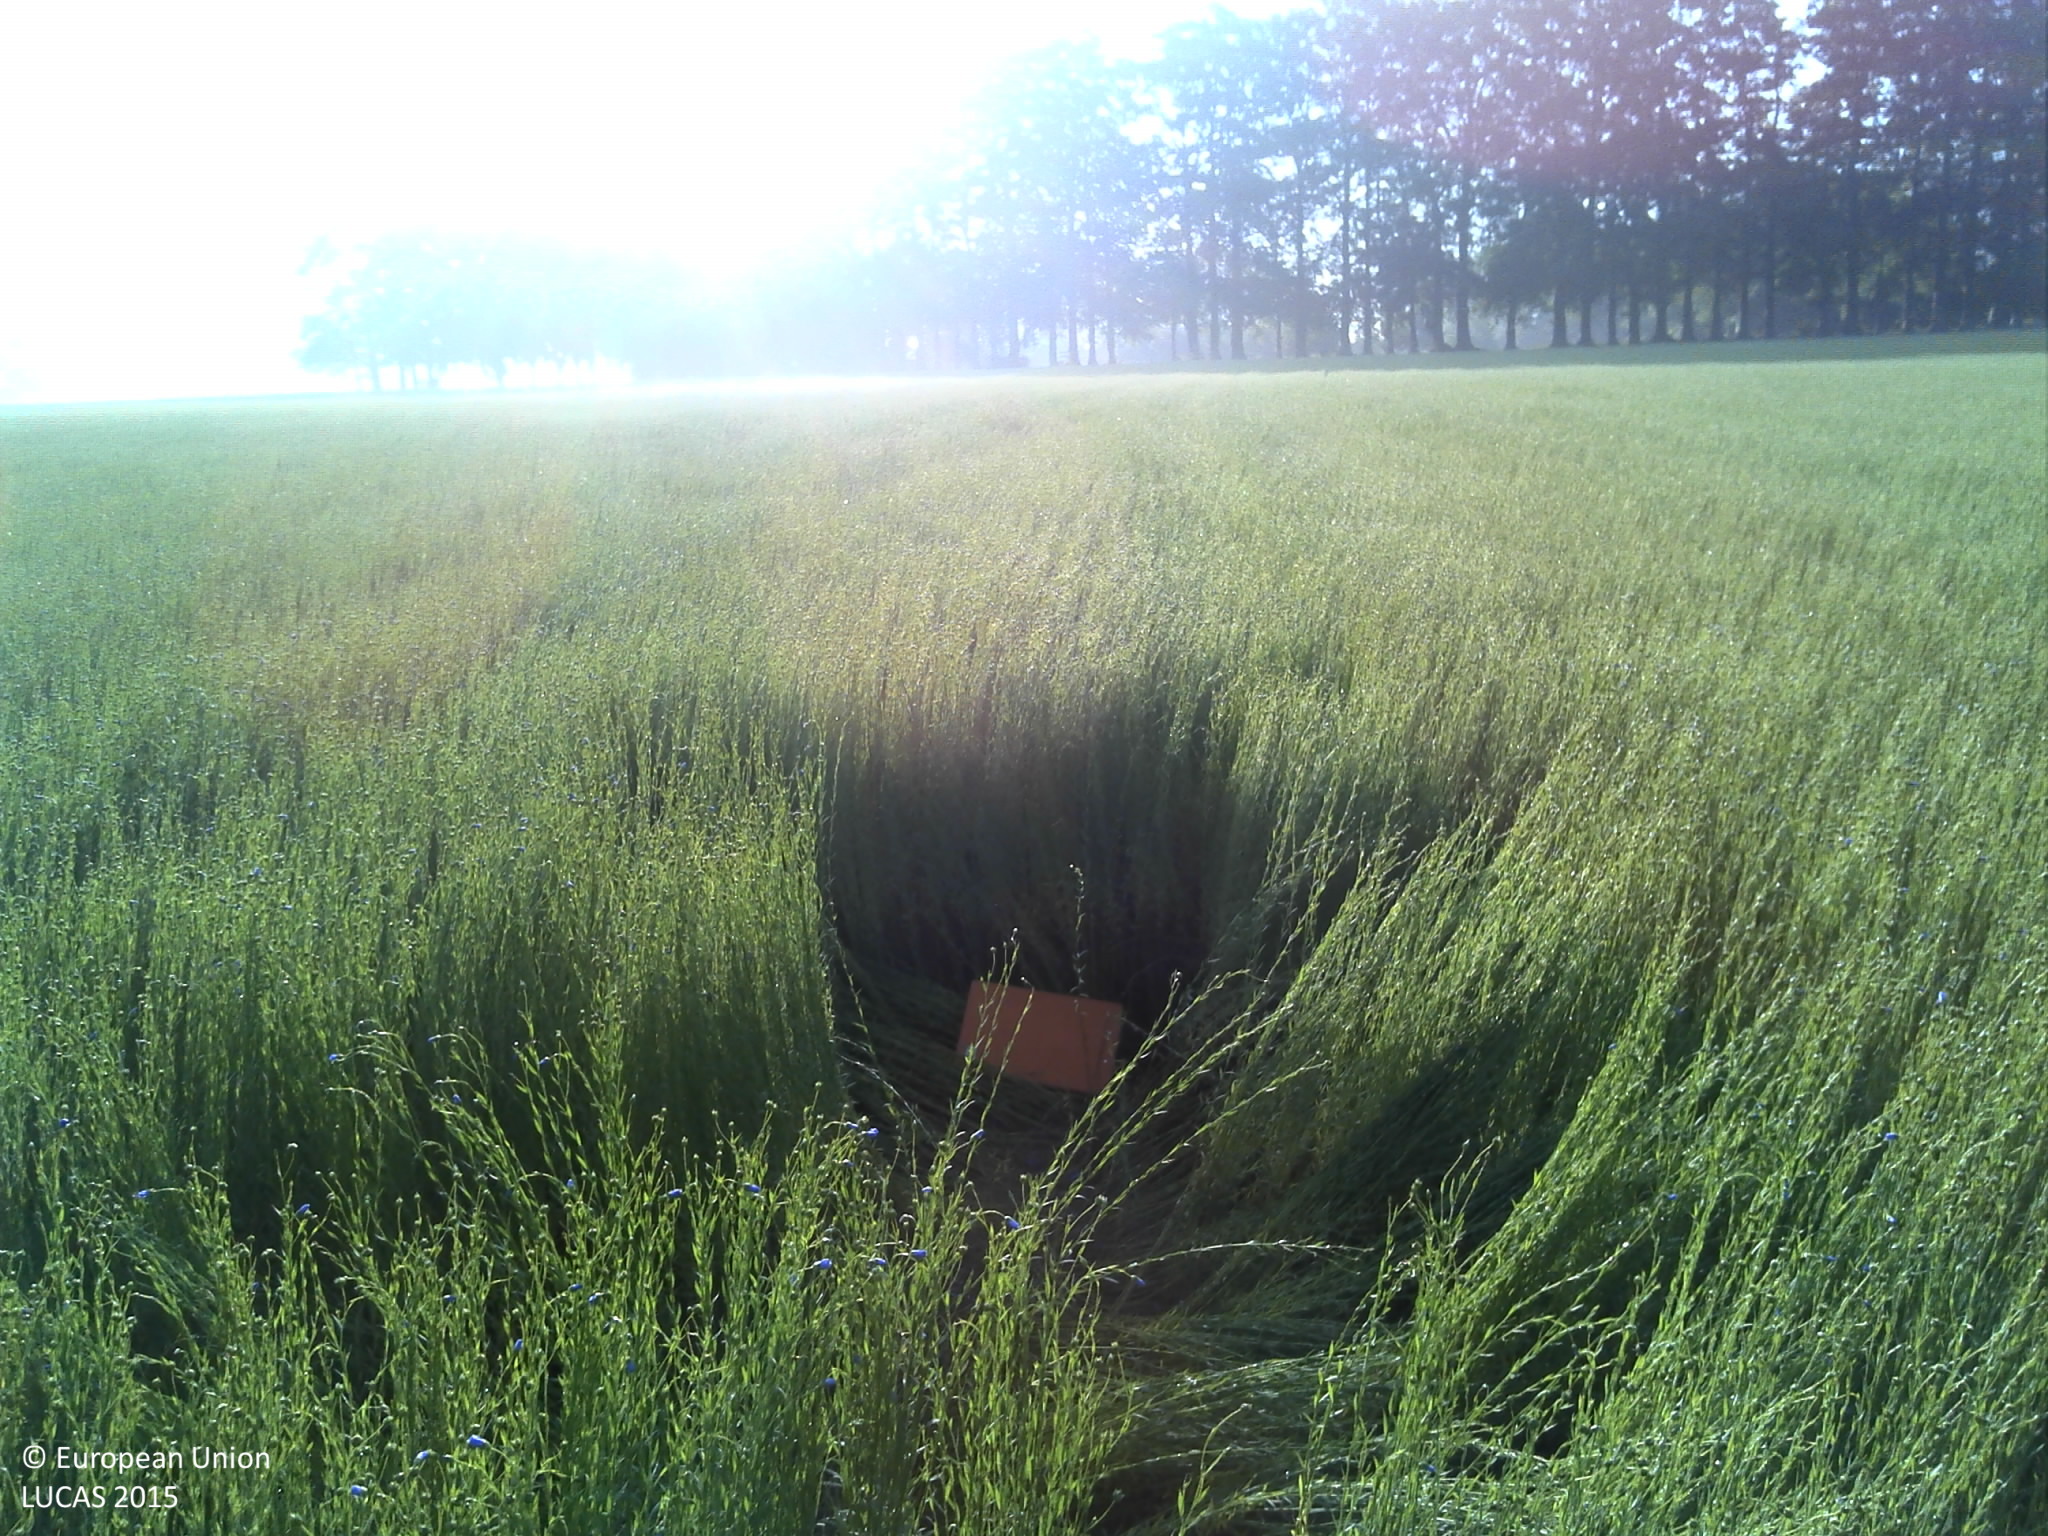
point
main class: Cropland
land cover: Other fibre and oleaginous crops
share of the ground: > 75 %
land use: Agriculture (excluding fallow land and kitchen gardens)
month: June
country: FR
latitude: 49.5943
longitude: 0.5802
